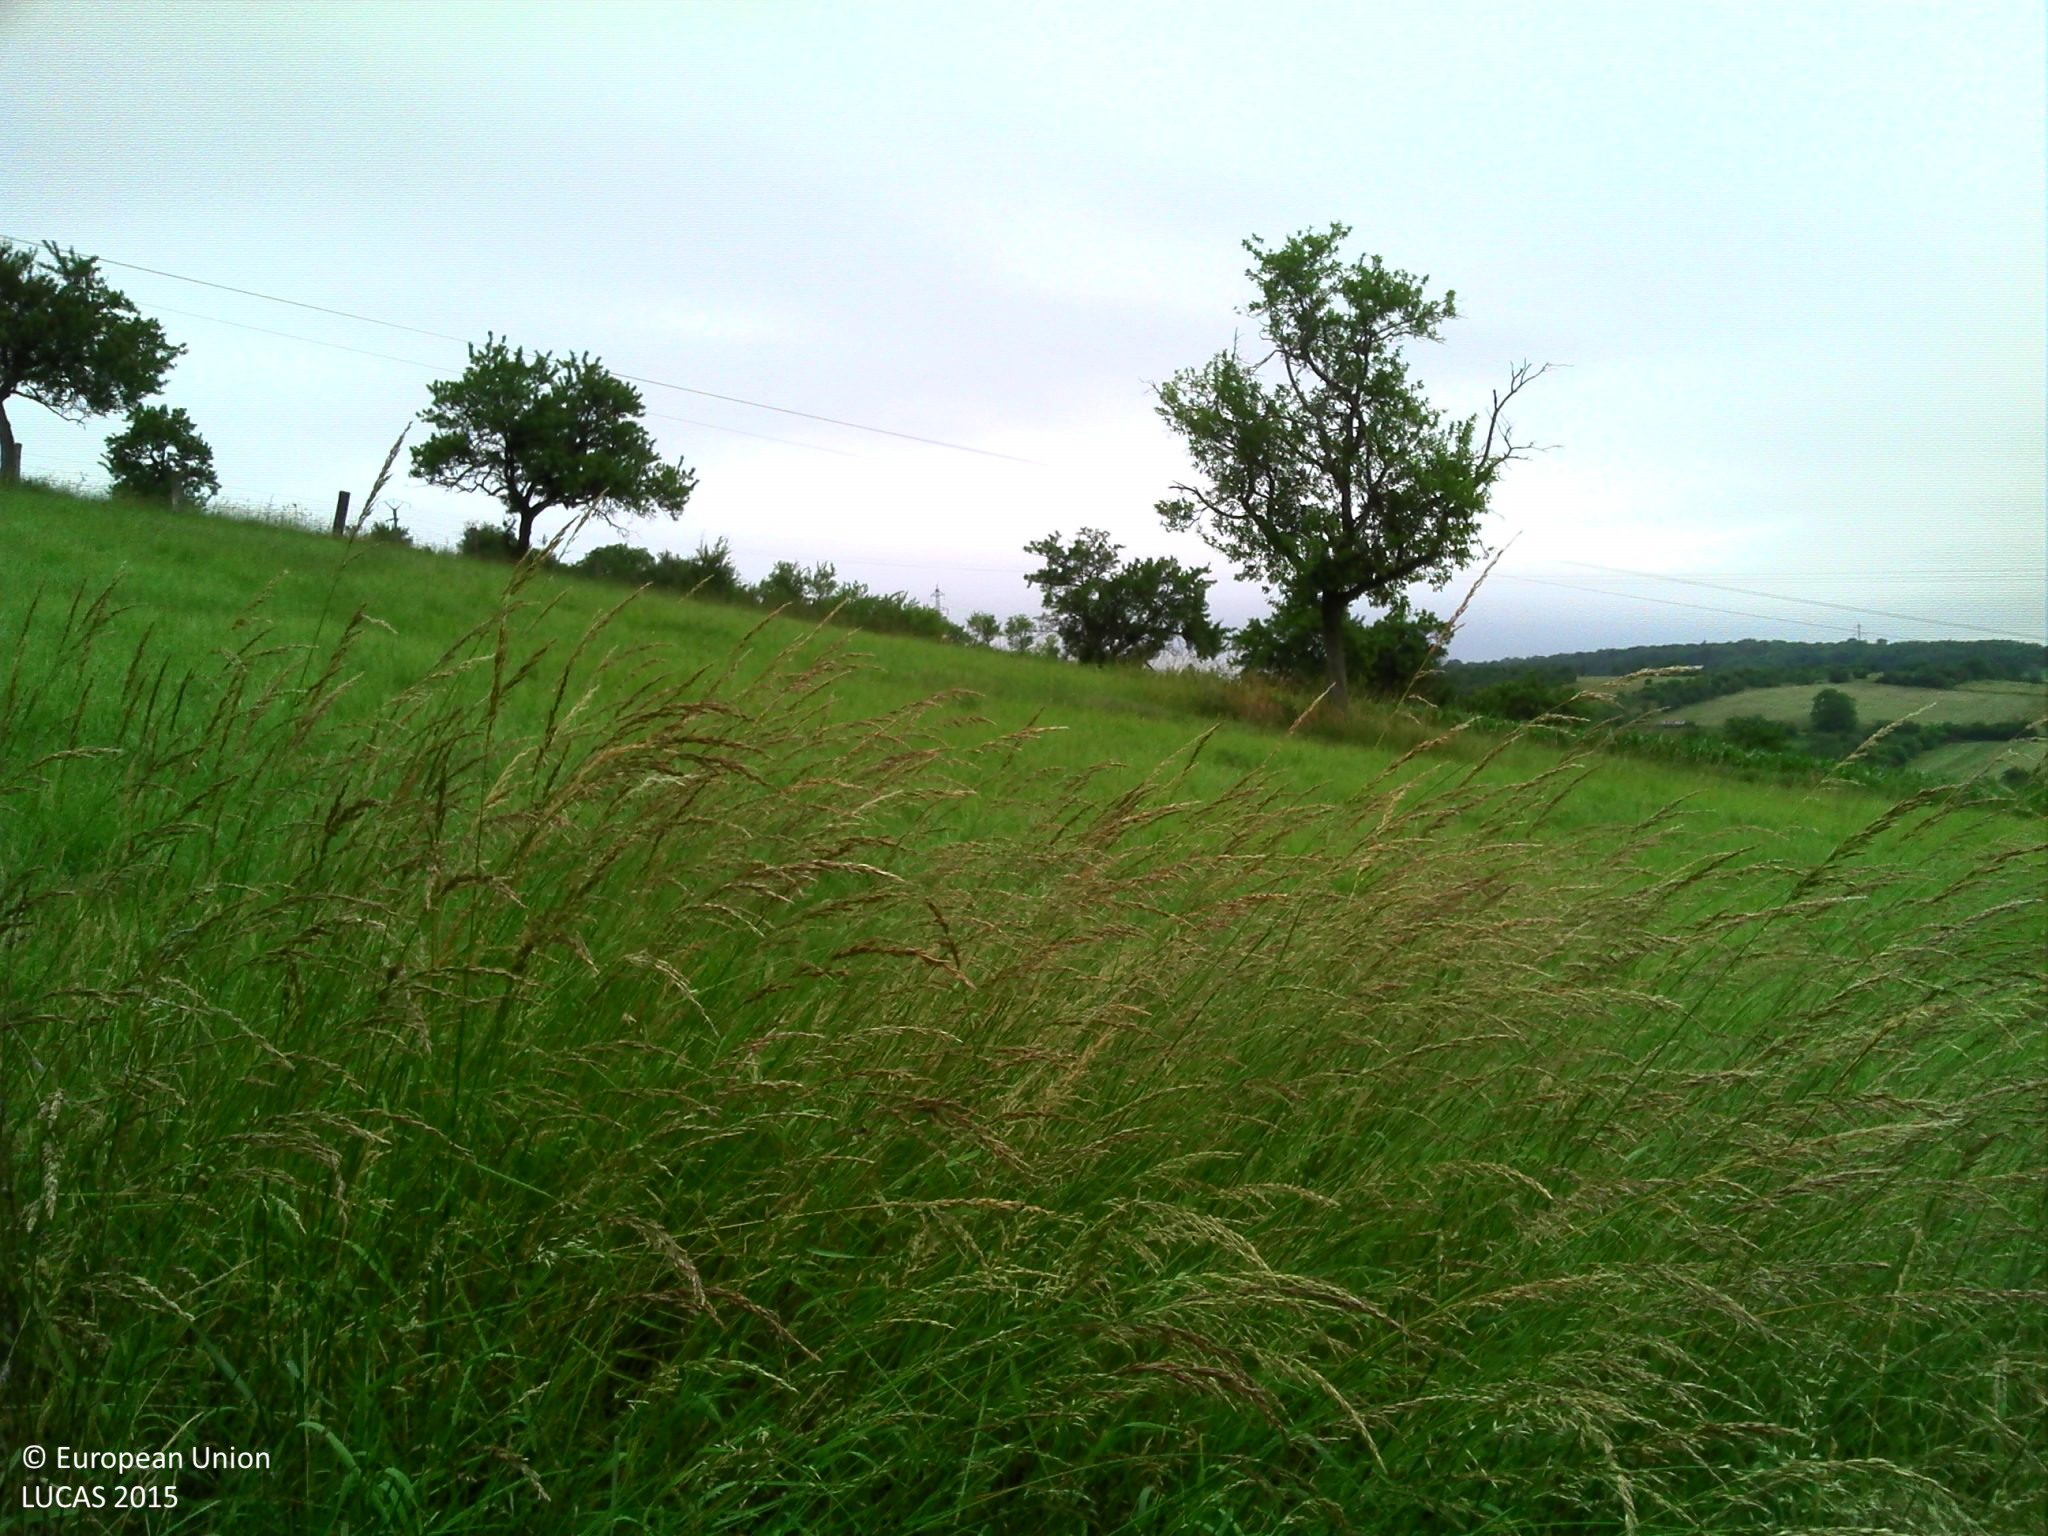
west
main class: Grassland
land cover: Grassland without tree/shrub cover
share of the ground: > 75 %
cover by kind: herbaceous plants 100 %
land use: Agriculture (excluding fallow land and kitchen gardens)
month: June
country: FR
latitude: 48.5578
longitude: 6.3013
